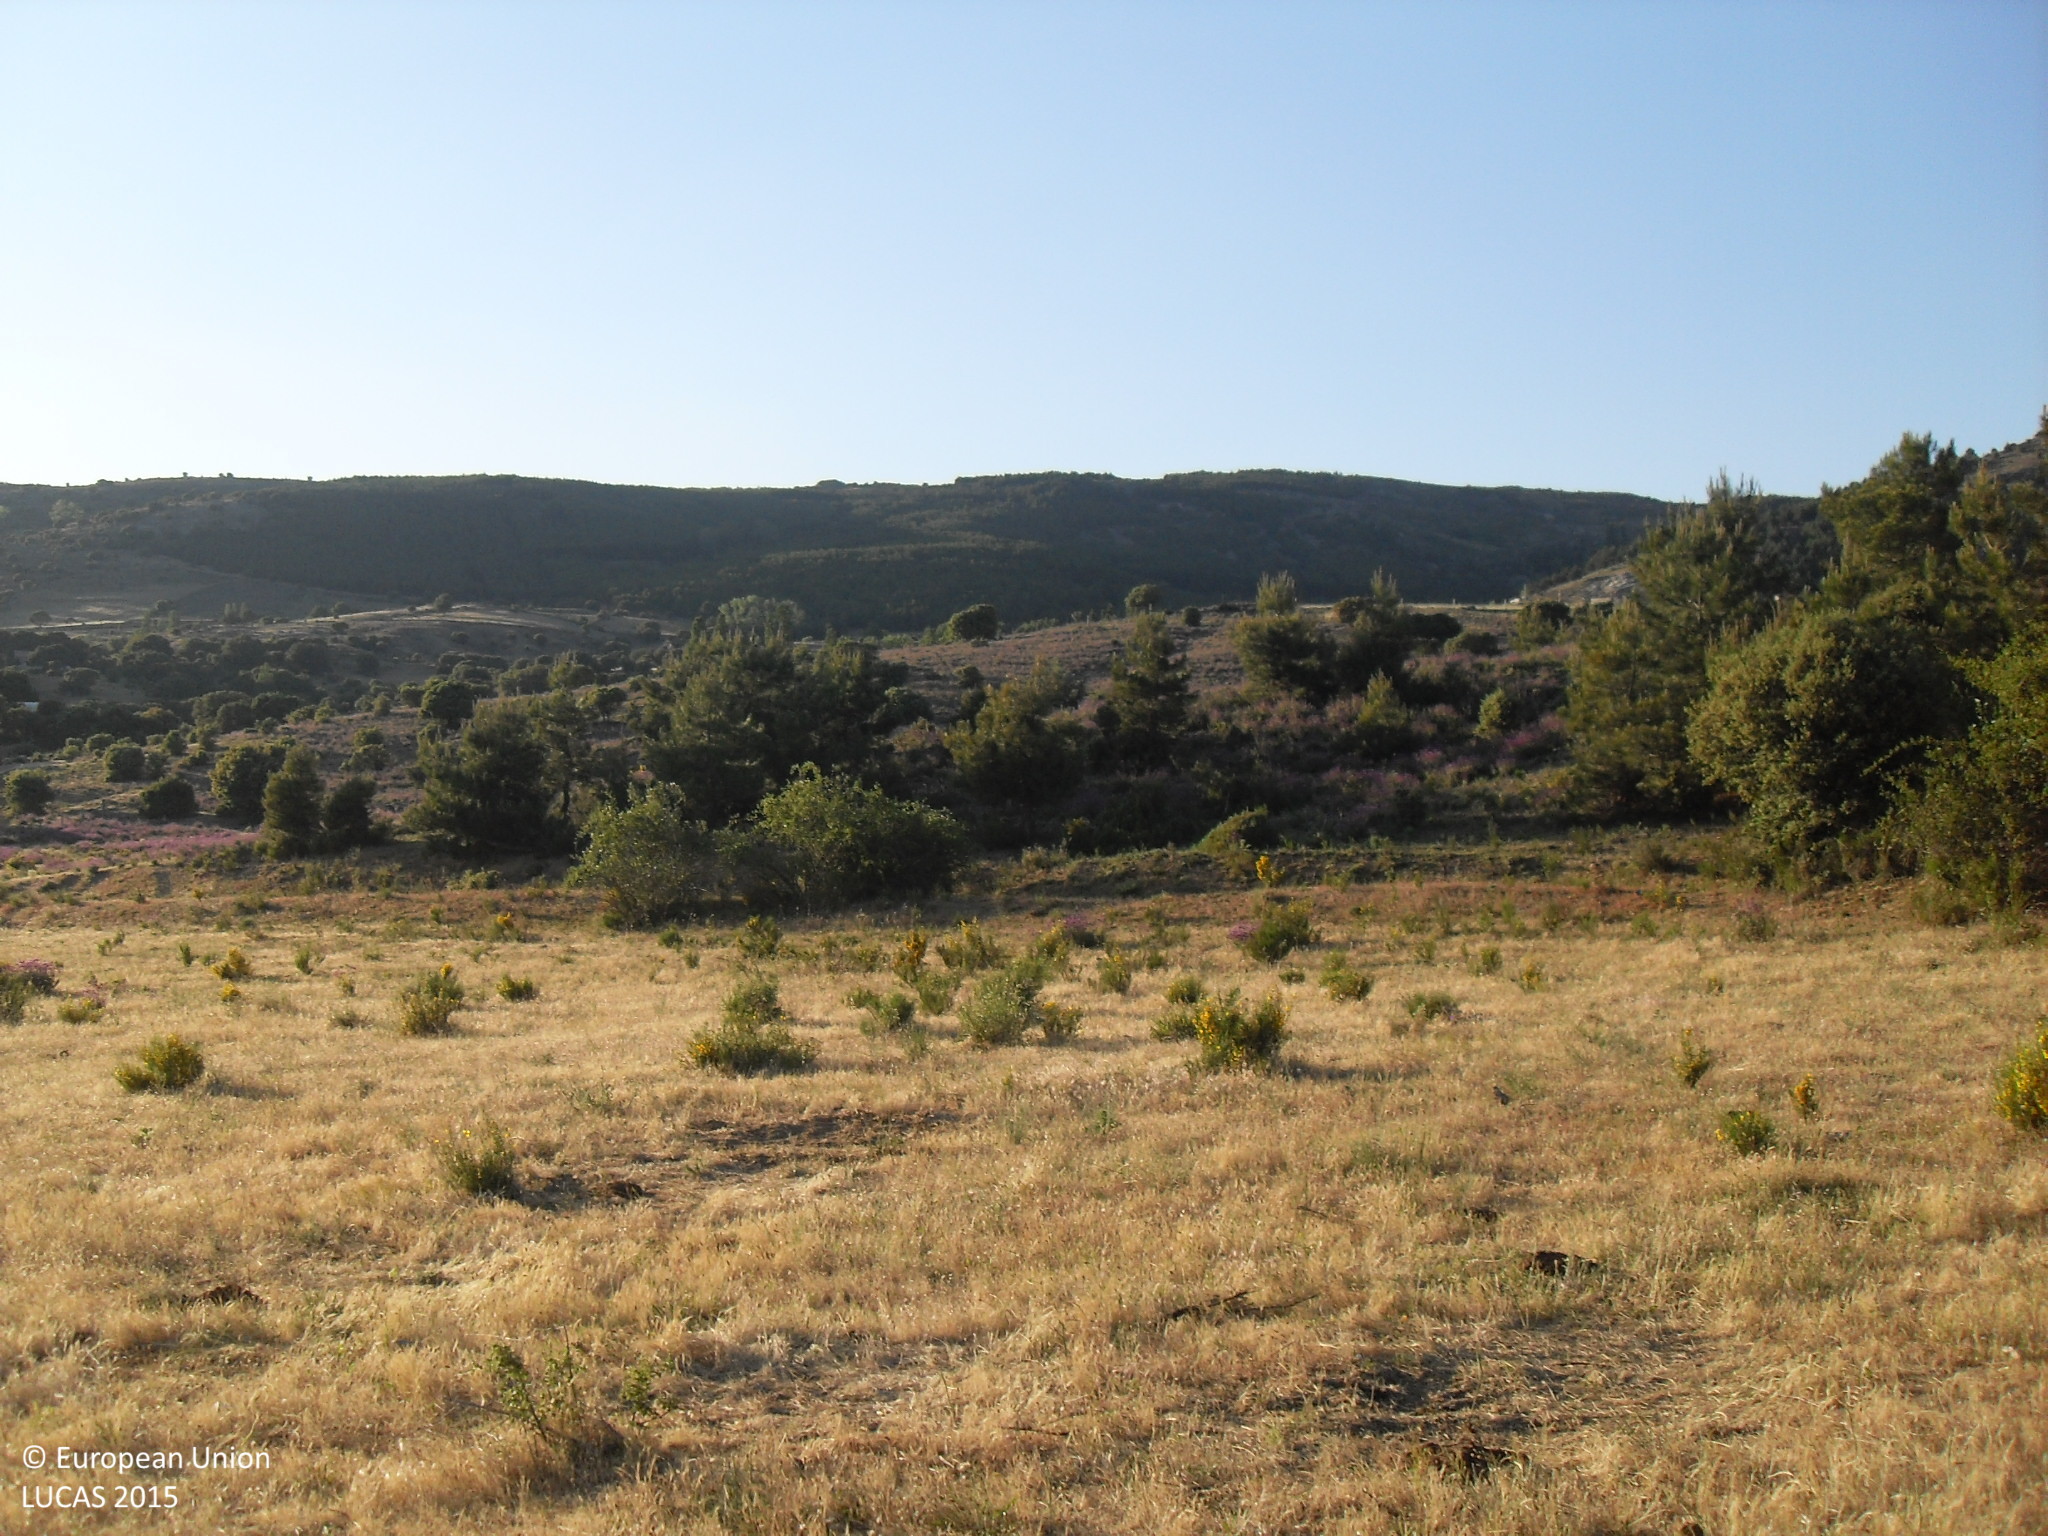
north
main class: Grassland
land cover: Grassland without tree/shrub cover
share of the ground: > 75 %
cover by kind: herbaceous plants 100 %
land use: Agriculture (excluding fallow land and kitchen gardens)
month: May
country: ES
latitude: 40.5534
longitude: -5.2621
